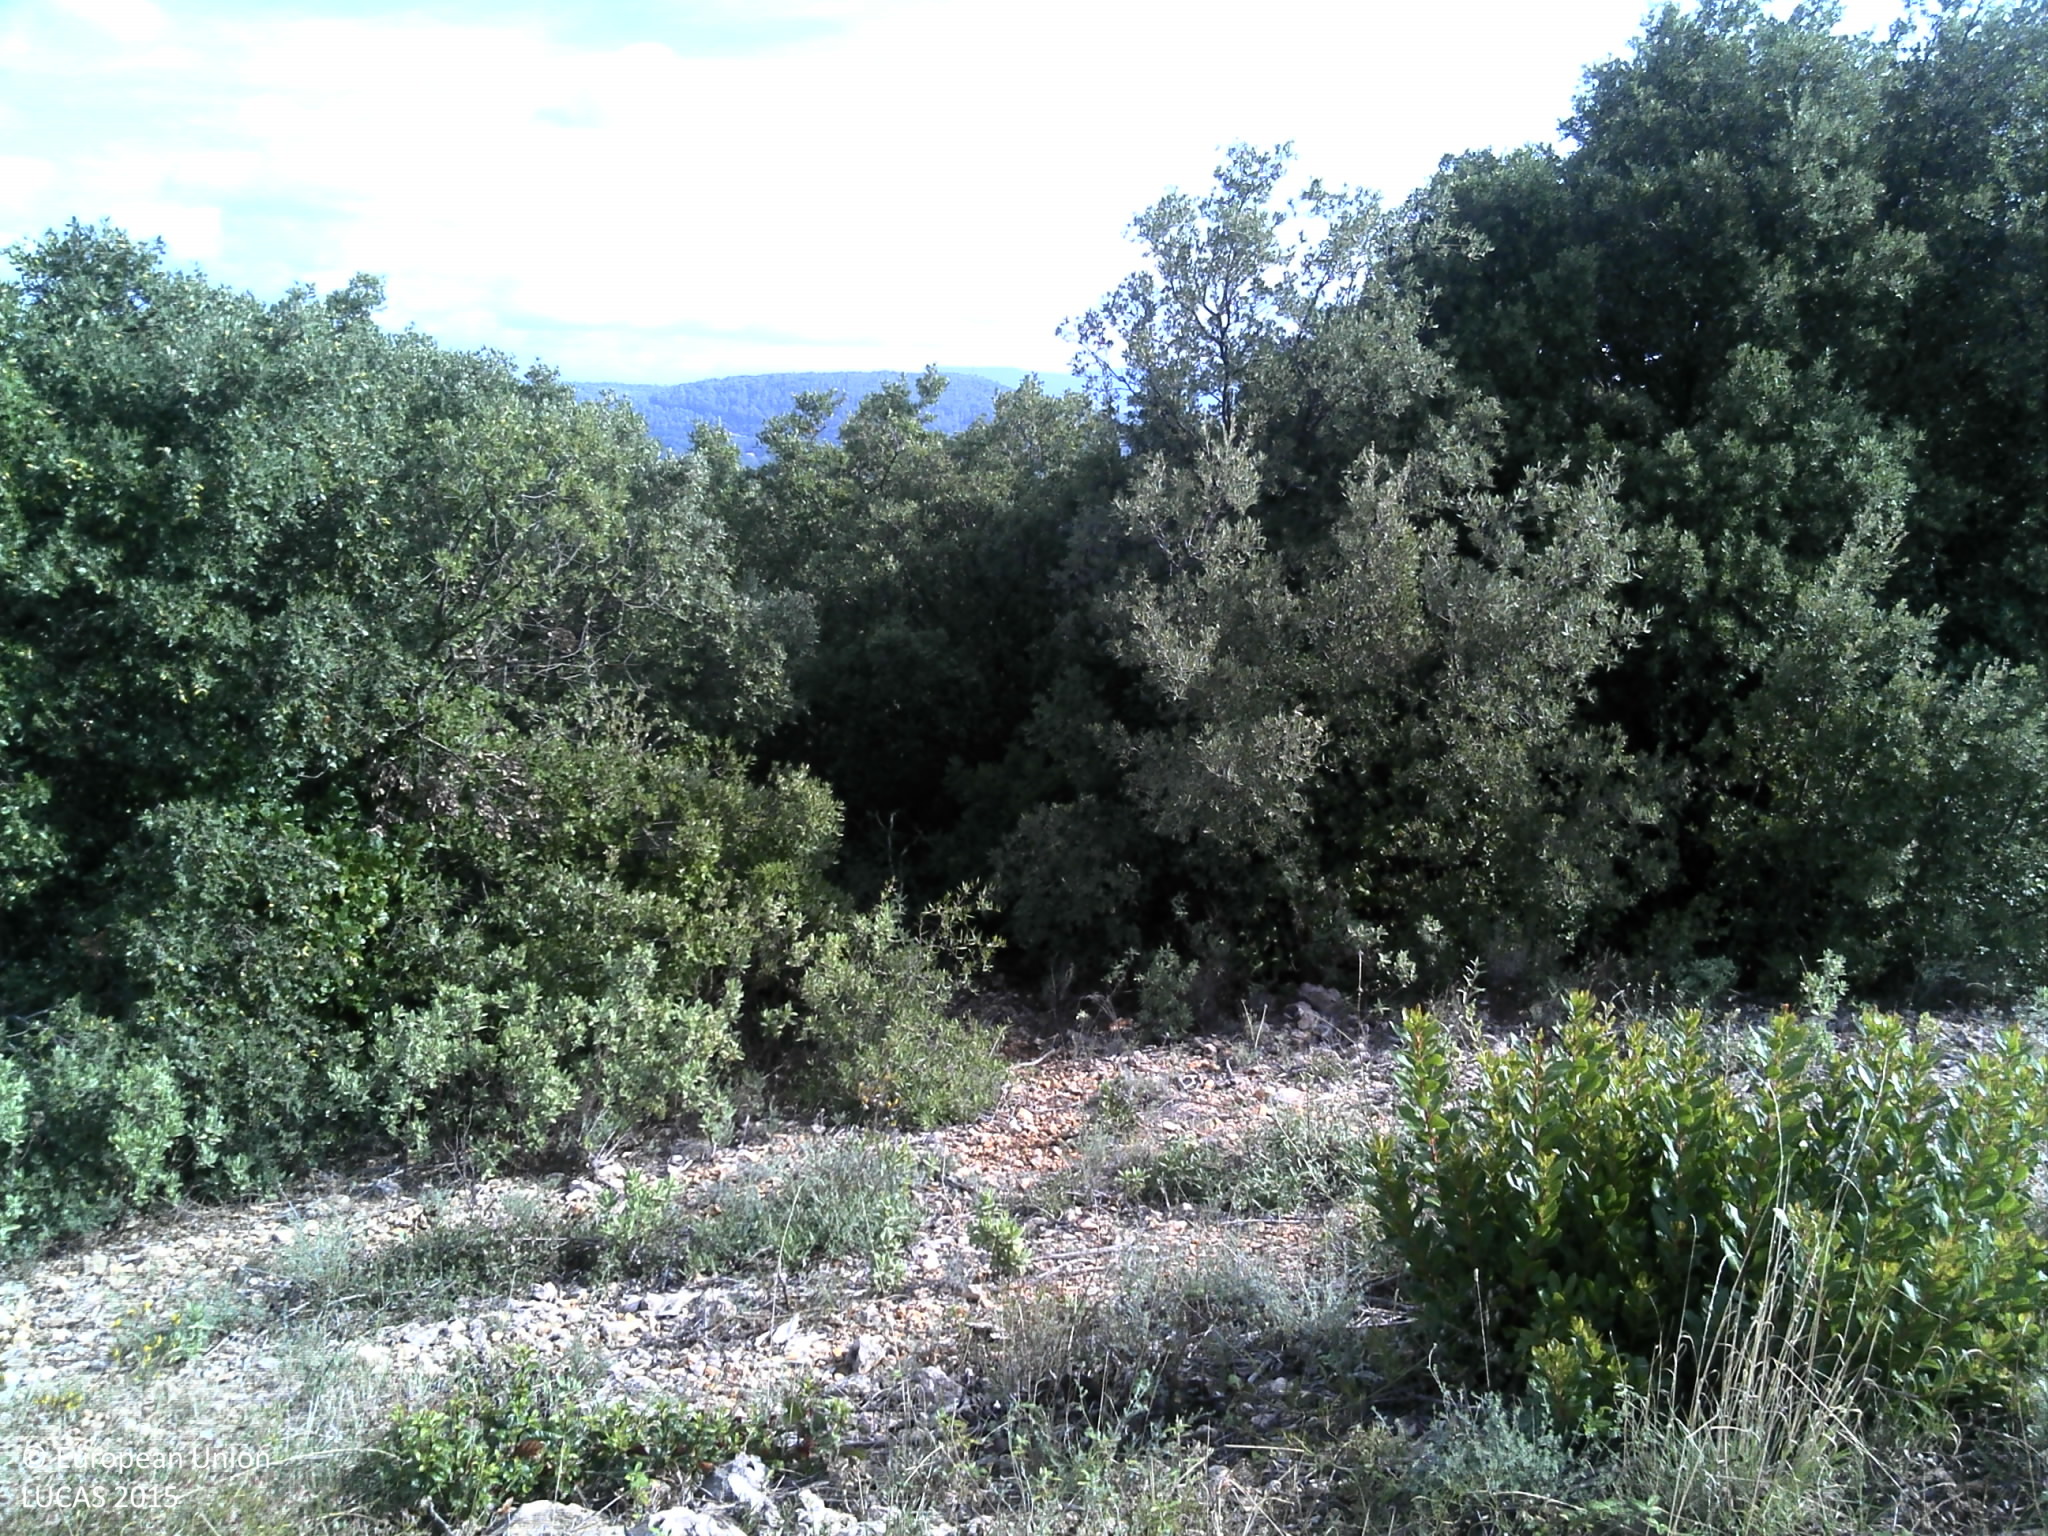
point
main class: Woodland
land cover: Broadleaved woodland
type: broadleaved evergreen forest
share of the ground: > 75 %
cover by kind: broadleaved forest trees 80 %, shrubs 10 %, unconsolidated bare surface 10 %
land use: Semi-natural and natural areas not in use
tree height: < 5 m
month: October
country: FR
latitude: 43.4793
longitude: 6.5097
